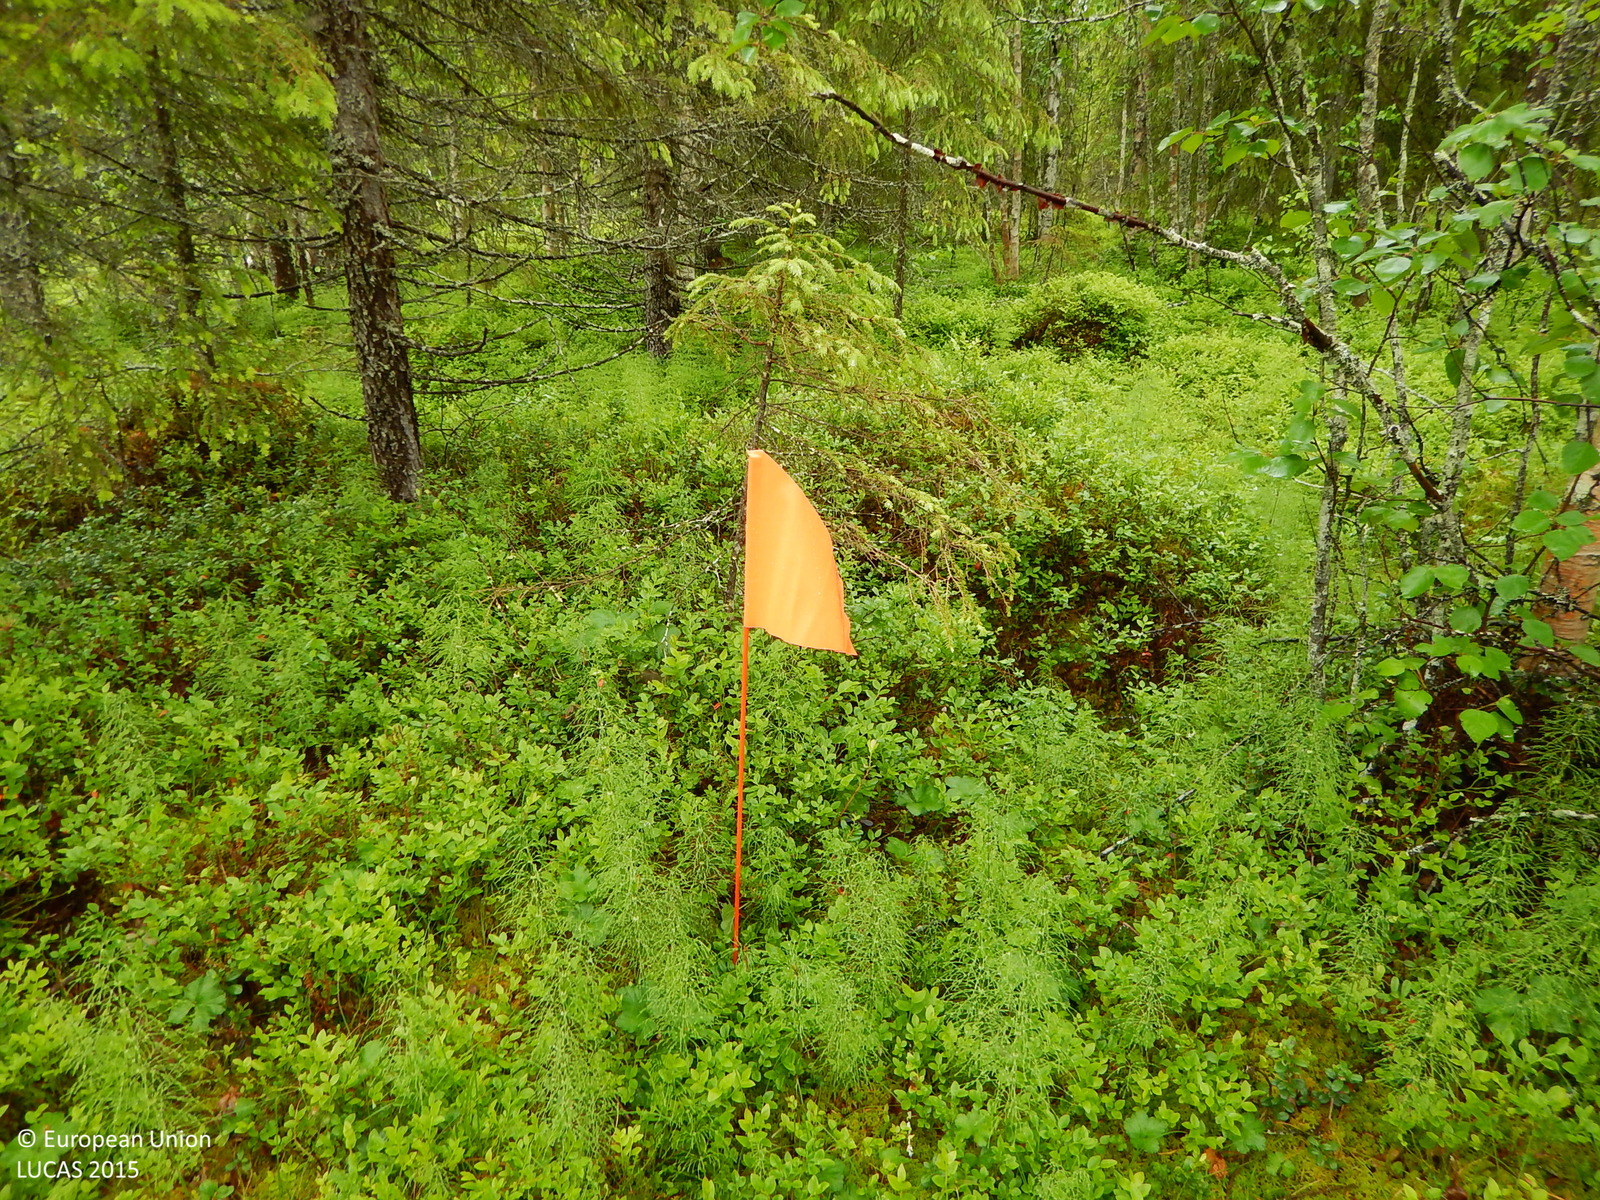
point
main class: Woodland
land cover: Other mixed woodland
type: boreal forest
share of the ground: 50 - 75 %
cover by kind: coniferous forest trees 40 %, herbaceous plants 20 %, lichens and mosses 20 %, broadleaved forest trees 15 %, shrubs 5 %
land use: Forestry
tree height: > 5 m
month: September
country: SE
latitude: 65.0953
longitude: 18.8816
